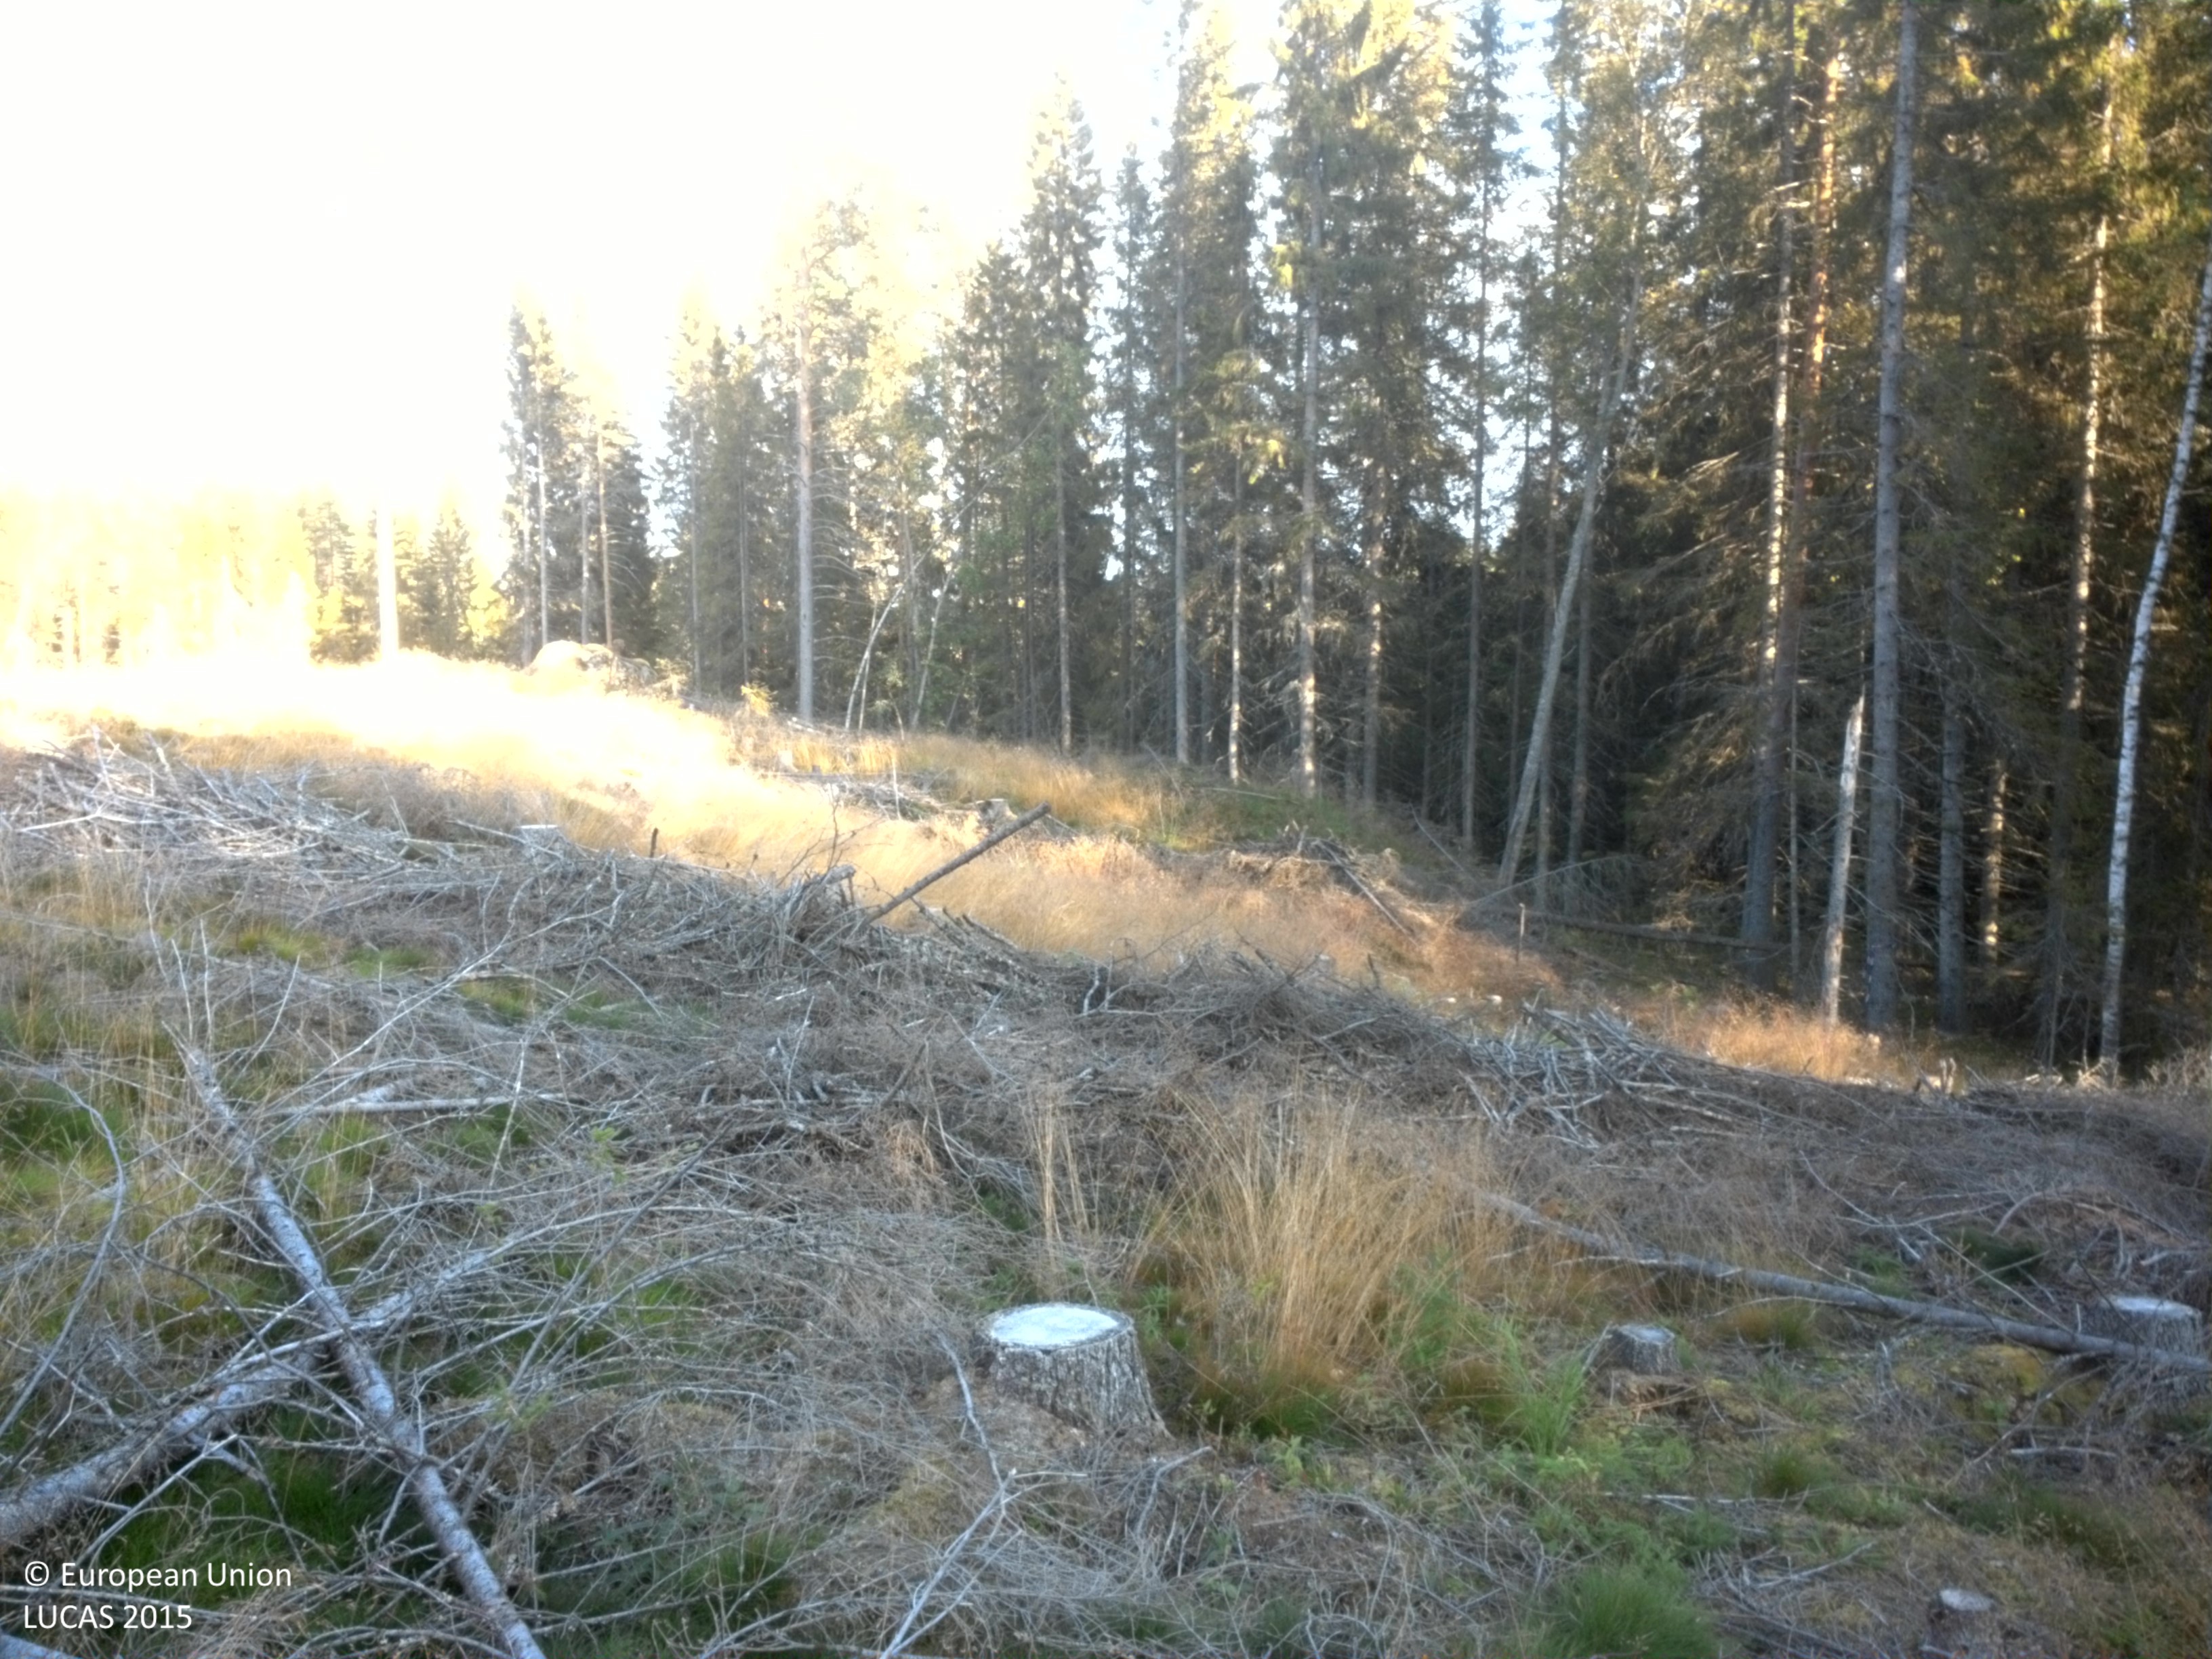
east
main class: Grassland
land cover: Grassland without tree/shrub cover
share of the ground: 50 - 75 %
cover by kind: herbaceous plants 60 %, lichens and mosses 15 %, shrubs 5 %
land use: Forestry
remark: Clear cut
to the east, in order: Grassland without tree/shrub cover; Other mixed woodland; Spruce dominated coniferous woodland; Spruce dominated mixed woodland; Inland fresh running water; Grassland without tree/shrub cover; Spruce dominated coniferous woodland; Grassland without tree/shrub cover; Inland fresh running water; Grassland with sparse tree/shrub cover; Broadleaved woodland; Pine dominated mixed woodland
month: September
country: SE
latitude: 64.3046
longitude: 20.5006
